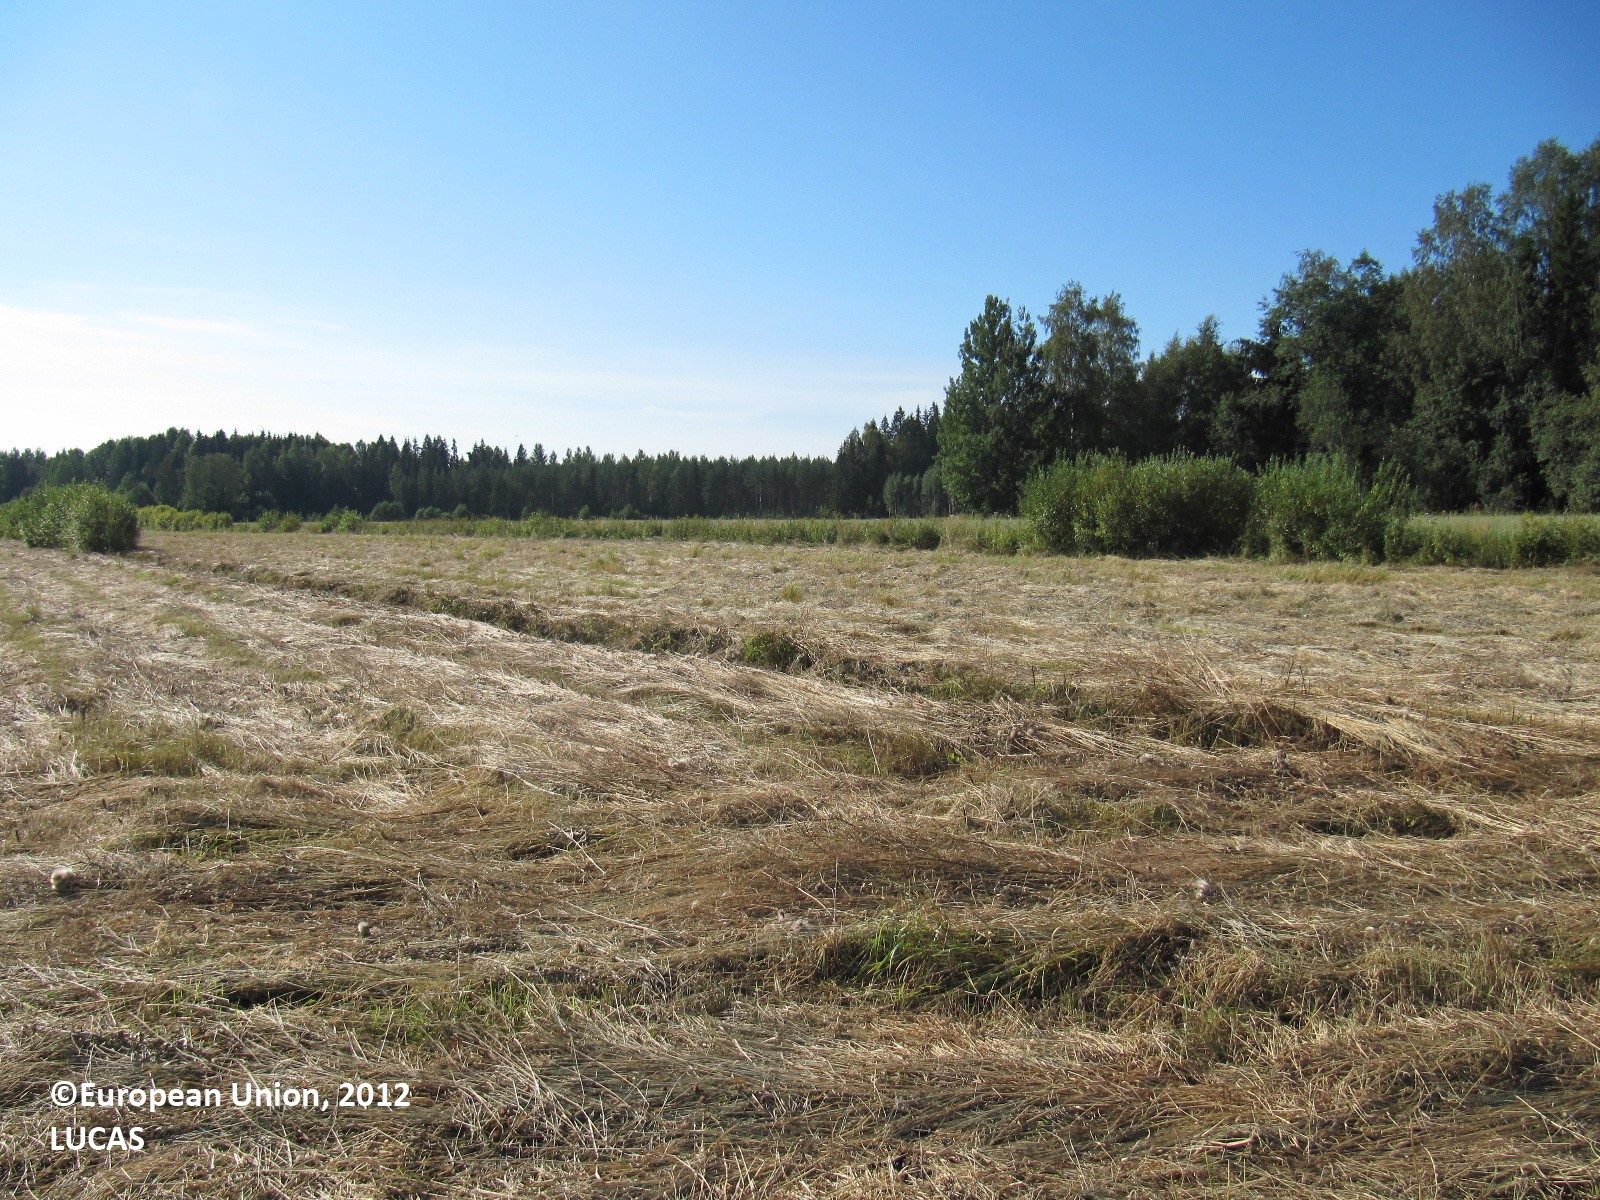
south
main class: Grassland
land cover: Grassland without tree/shrub cover
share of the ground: > 75 %
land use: Agriculture (excluding fallow land and kitchen gardens)
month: August
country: FI
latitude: 60.7080
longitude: 24.5255
